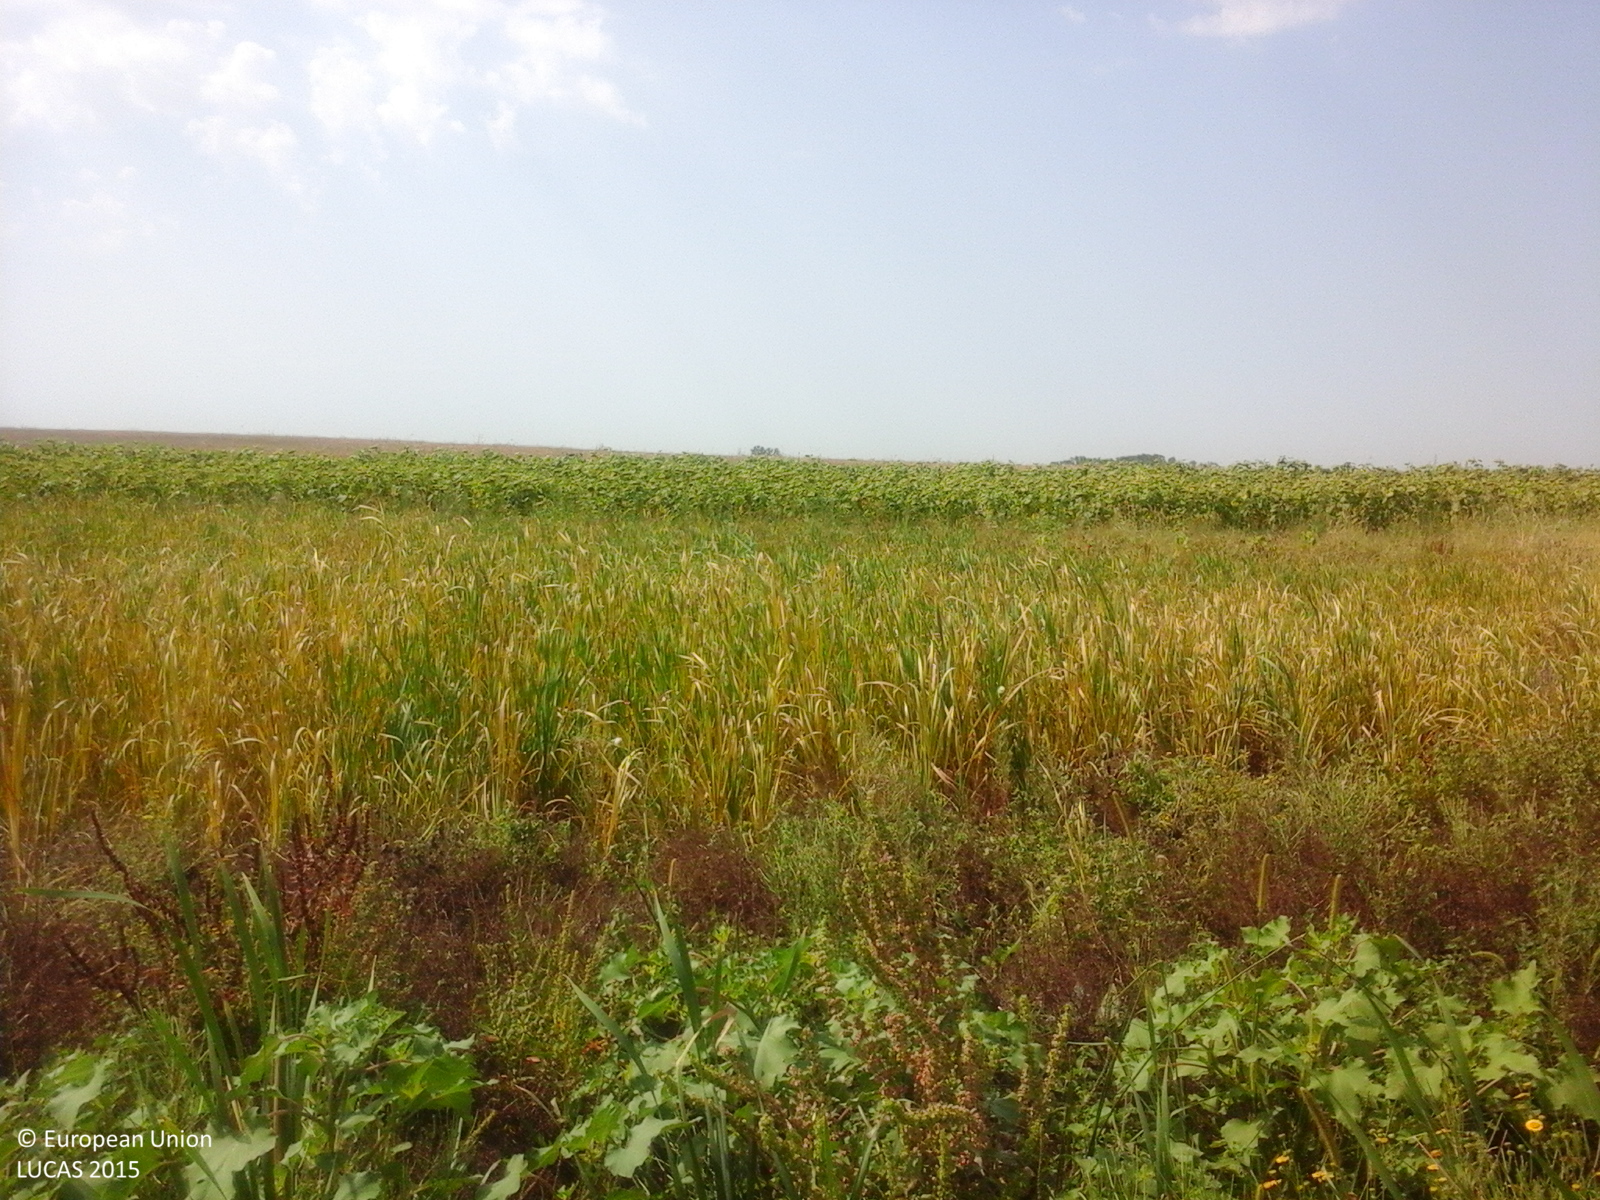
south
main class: Grassland
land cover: Spontaneously vegetated surfaces
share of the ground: > 75 %
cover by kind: herbaceous plants 100 %
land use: Agriculture (excluding fallow land and kitchen gardens)
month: August
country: RO
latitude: 43.8495
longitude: 23.6212
